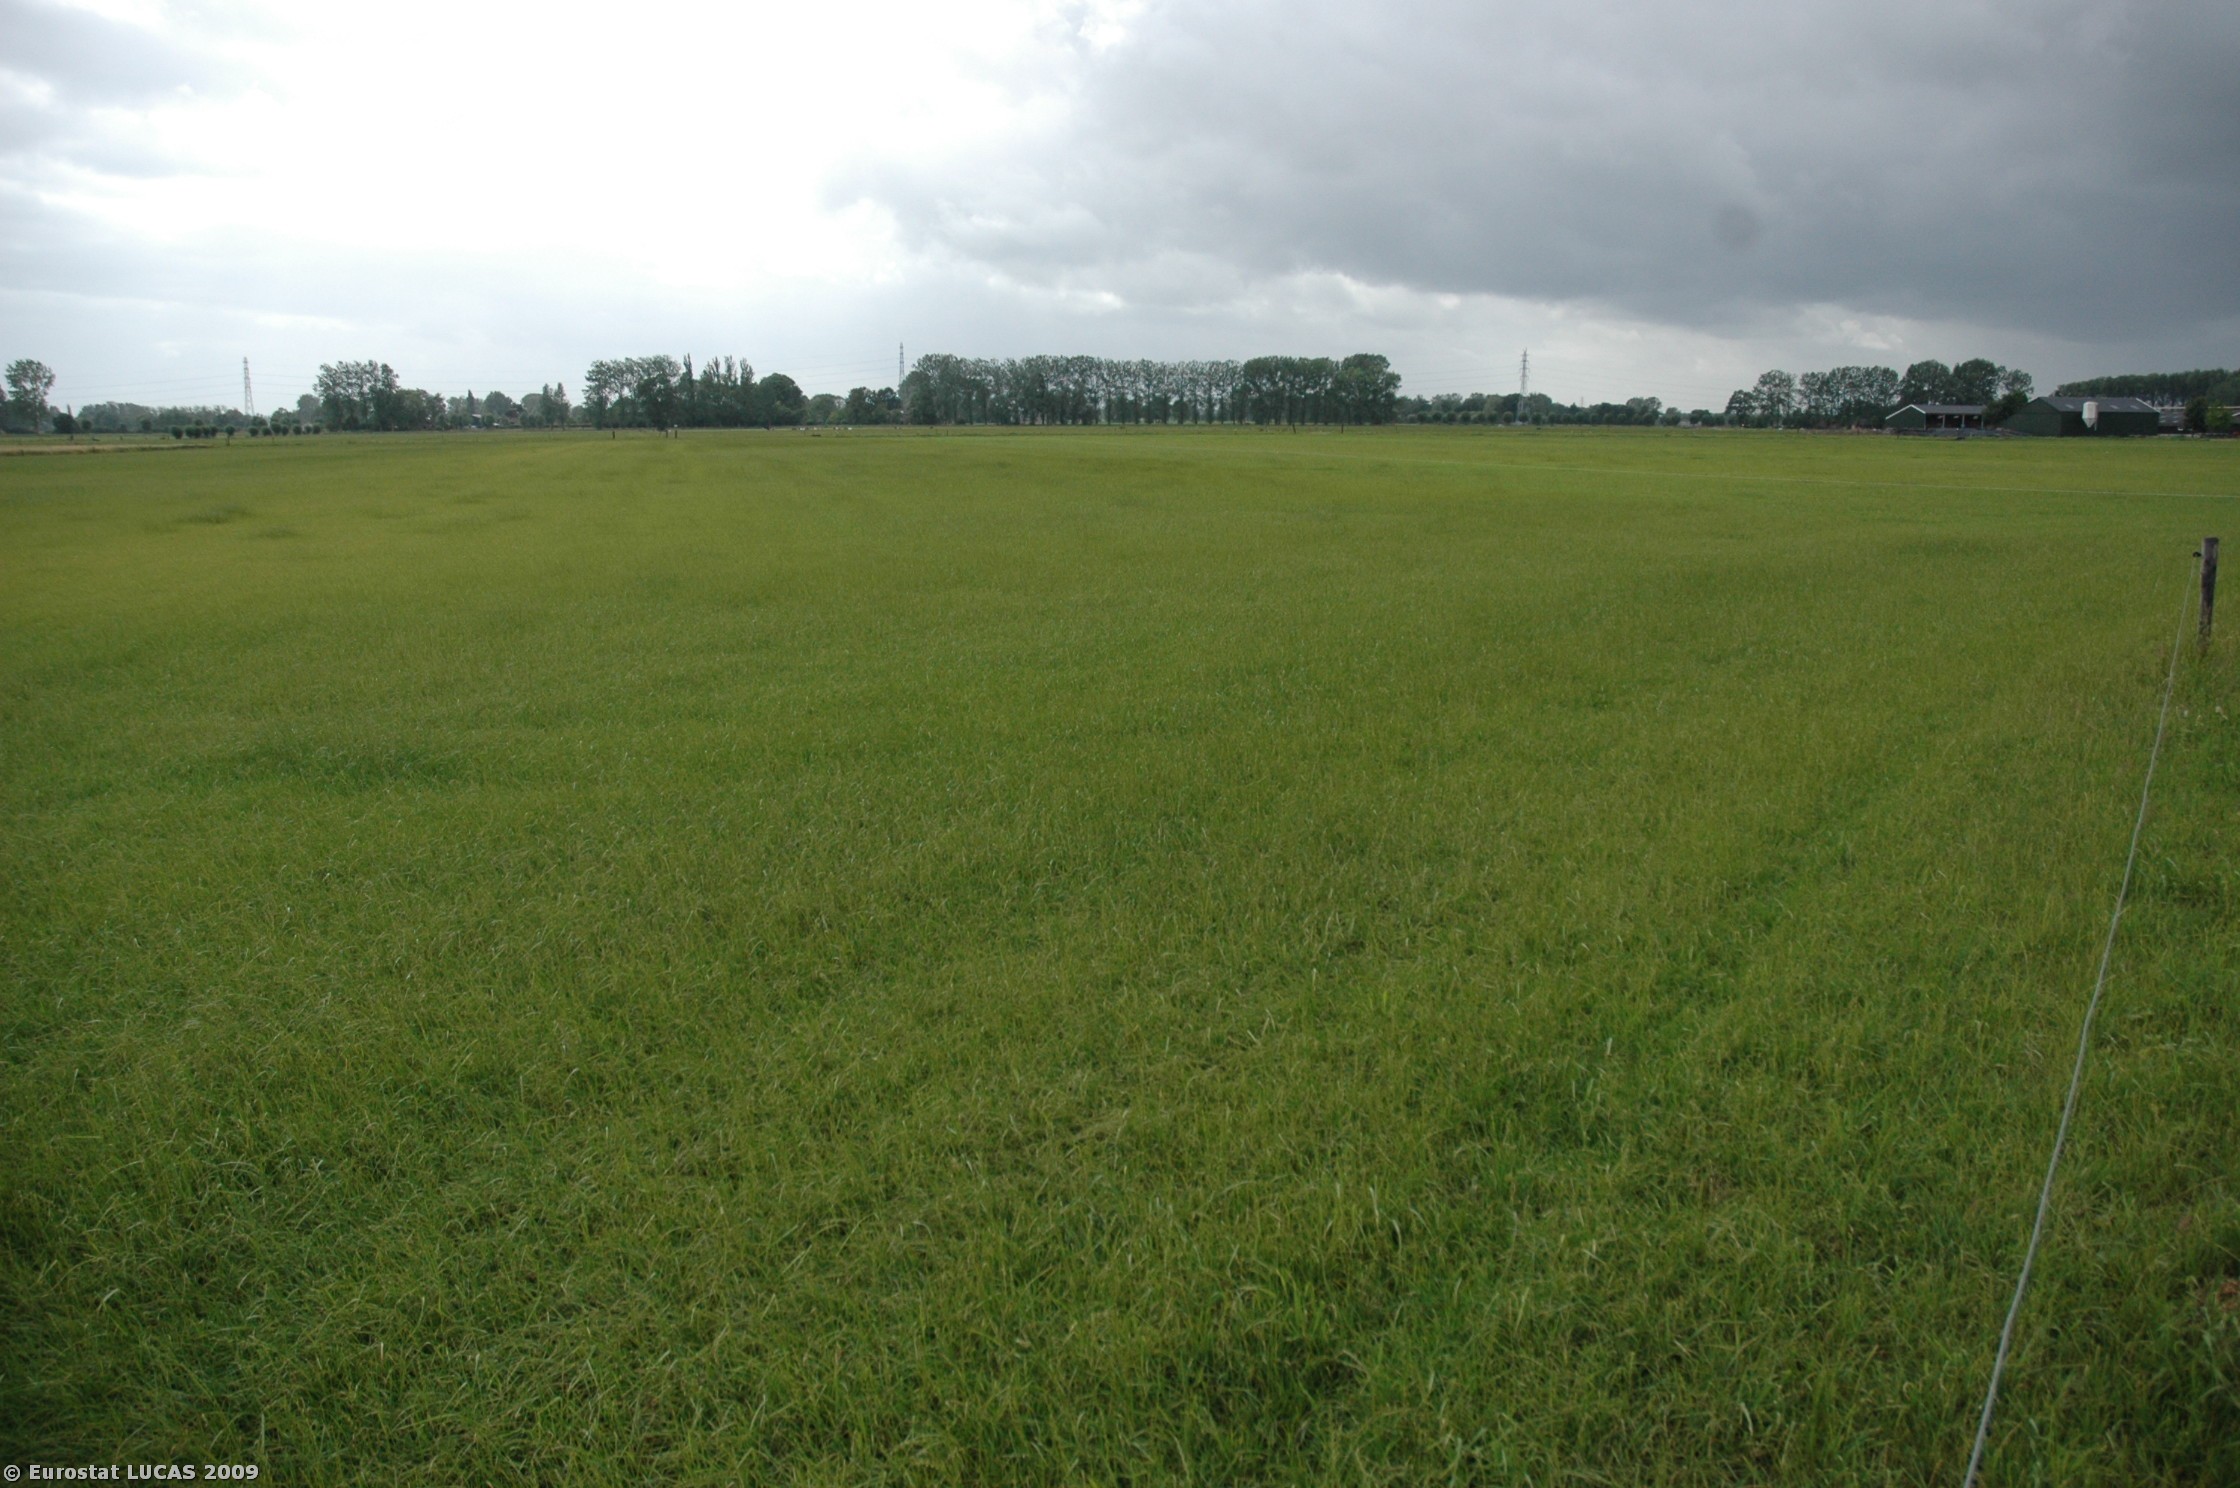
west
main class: Cropland
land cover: Common wheat
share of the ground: > 75 %
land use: Agriculture (excluding fallow land and kitchen gardens)
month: July
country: NL
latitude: 52.2950
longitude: 6.0844
